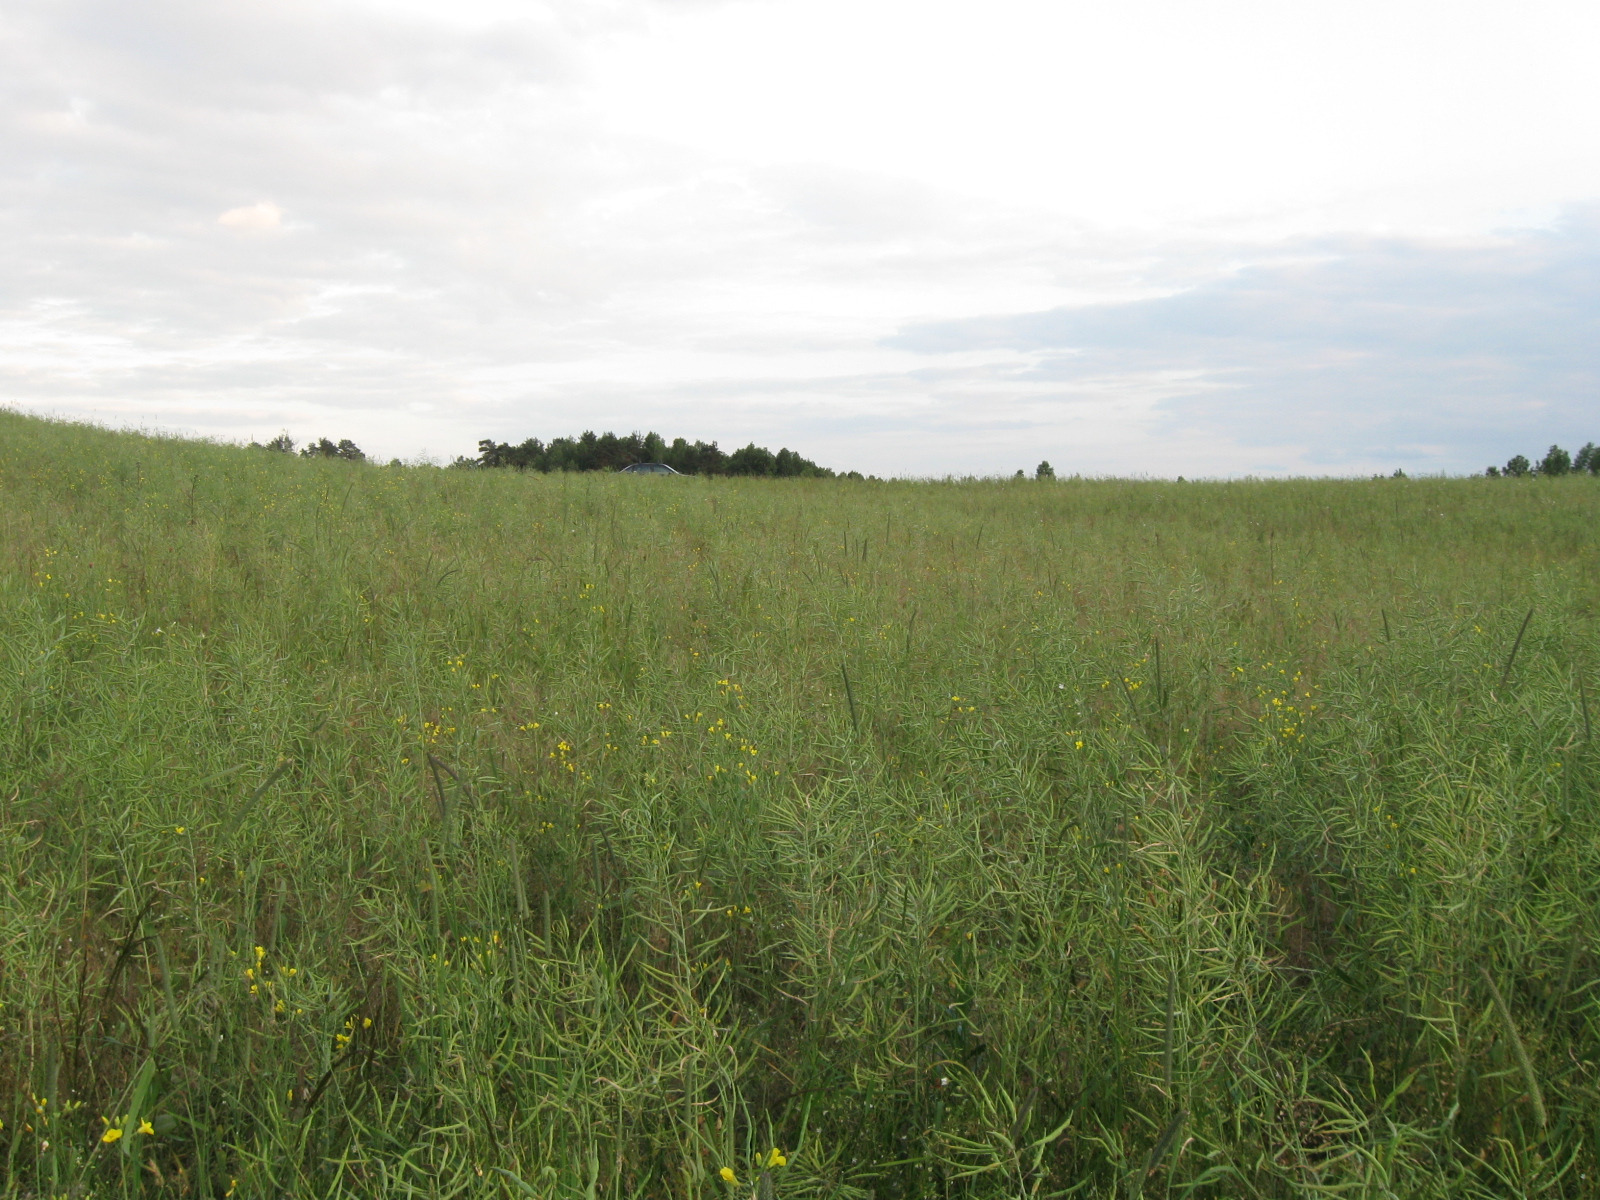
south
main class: Cropland
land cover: Rape and turnip rape
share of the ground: > 75 %
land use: Agriculture (excluding fallow land and kitchen gardens)
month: June
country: LT
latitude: 54.4123
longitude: 24.6049
